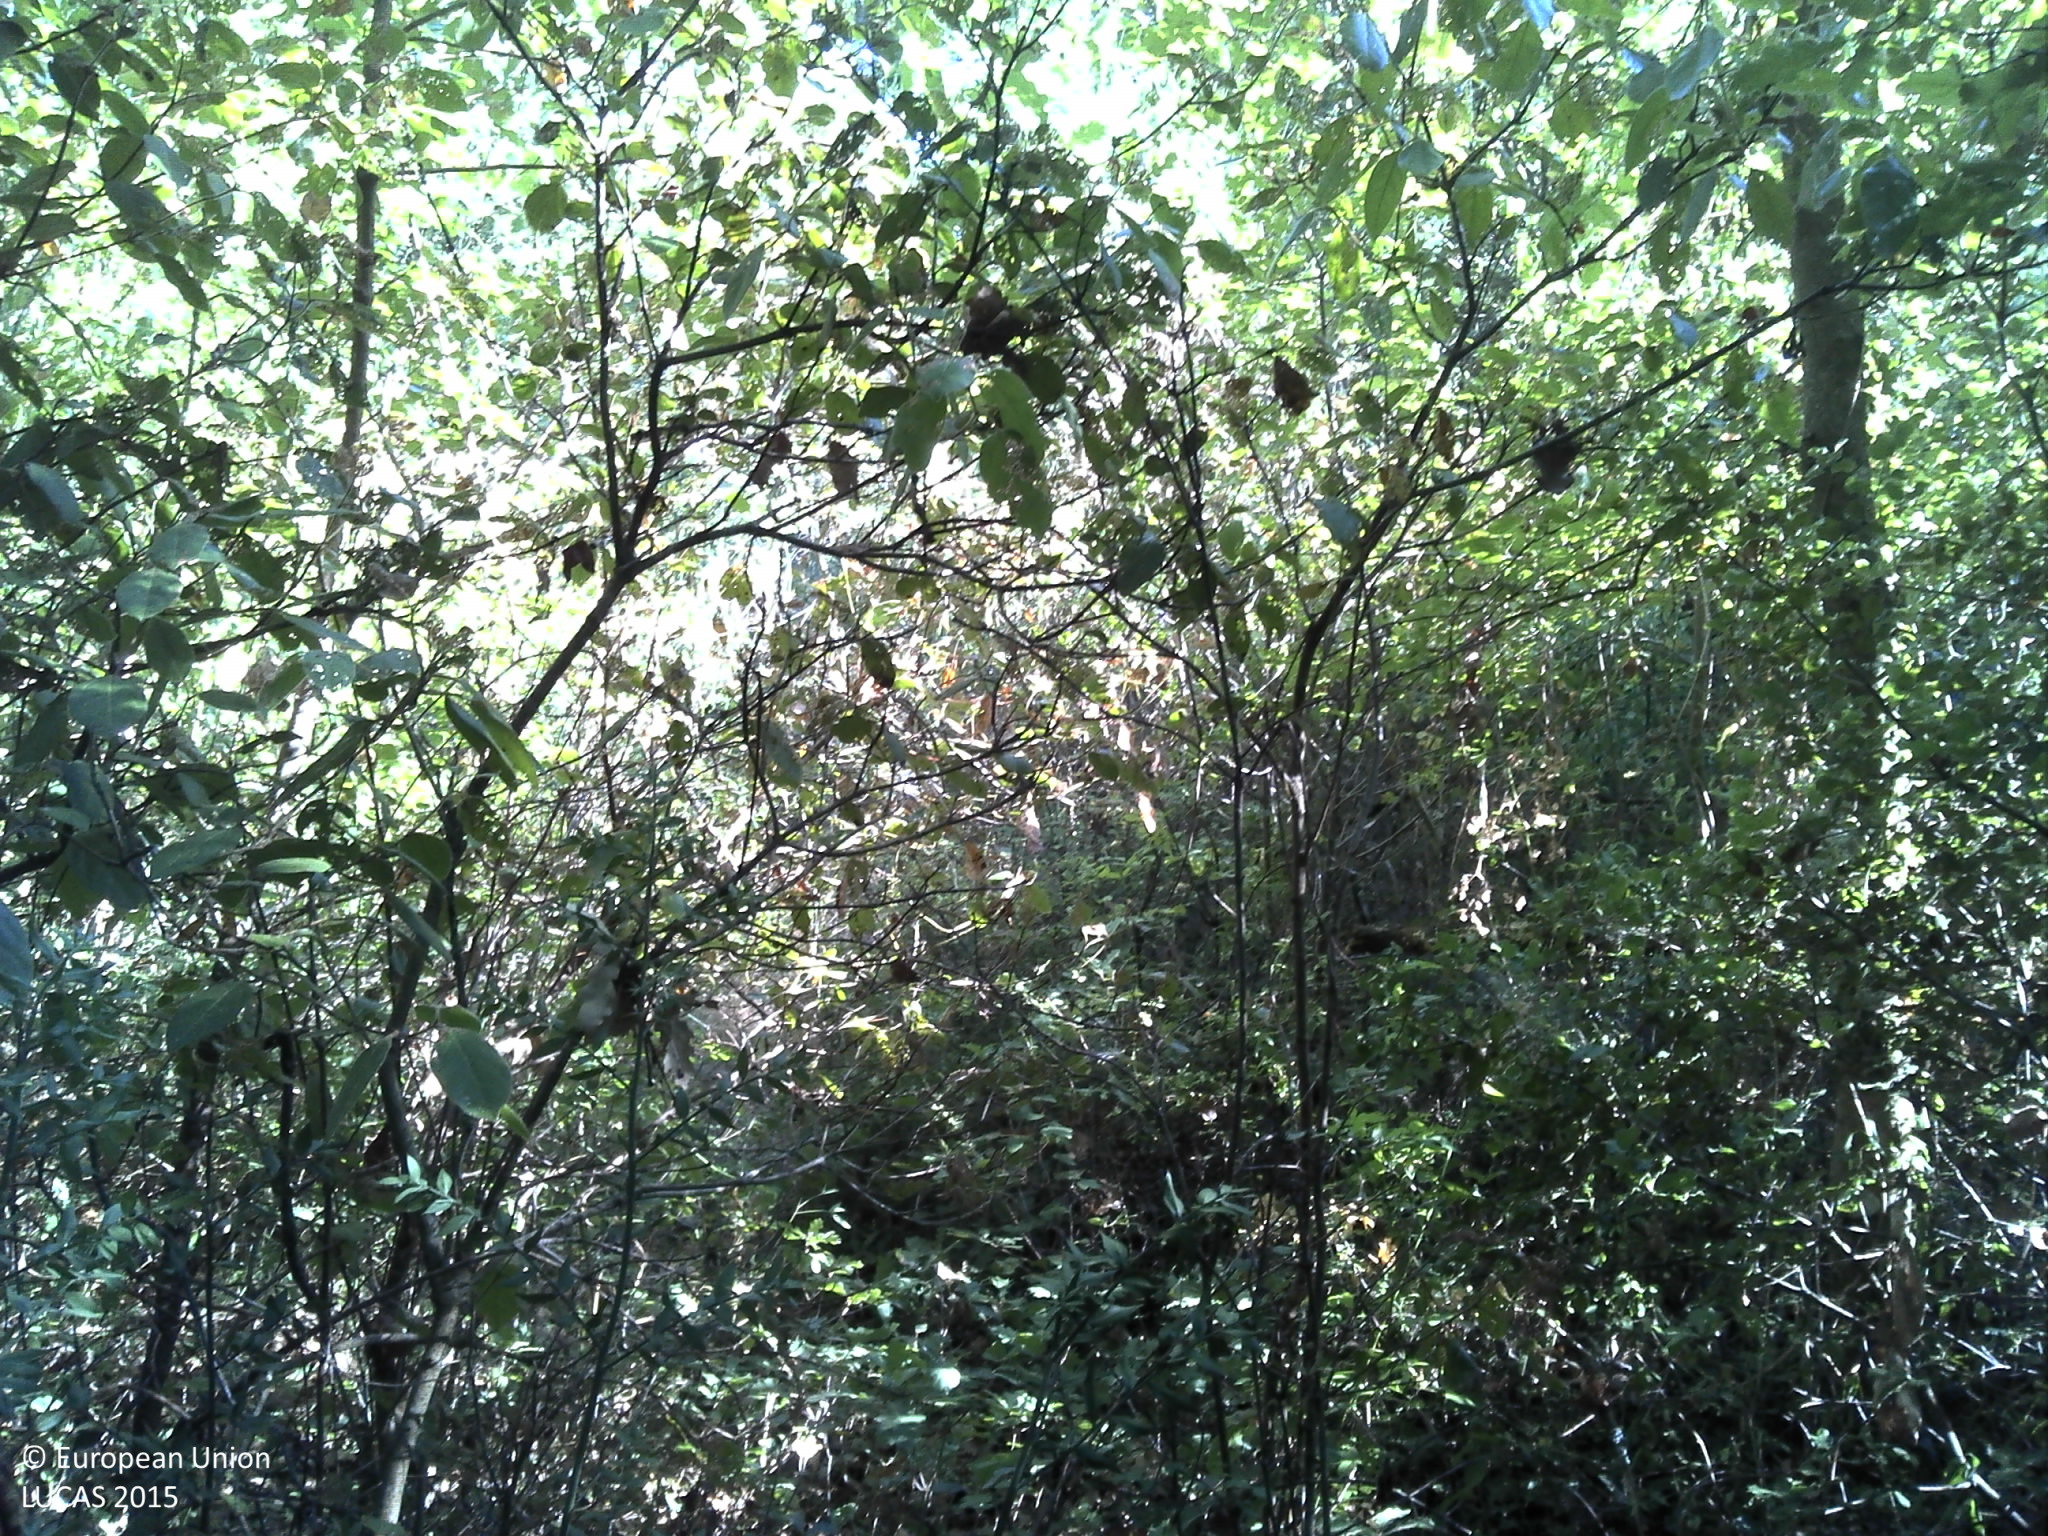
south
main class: Woodland
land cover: Broadleaved woodland
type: acidophilous oak and oak-birch forest
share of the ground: > 75 %
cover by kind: broadleaved forest trees 80 %, herbaceous plants 10 %, unconsolidated bare surface 10 %
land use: Semi-natural and natural areas not in use
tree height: > 5 m
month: July
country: FR
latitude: 43.6356
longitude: 3.1534
